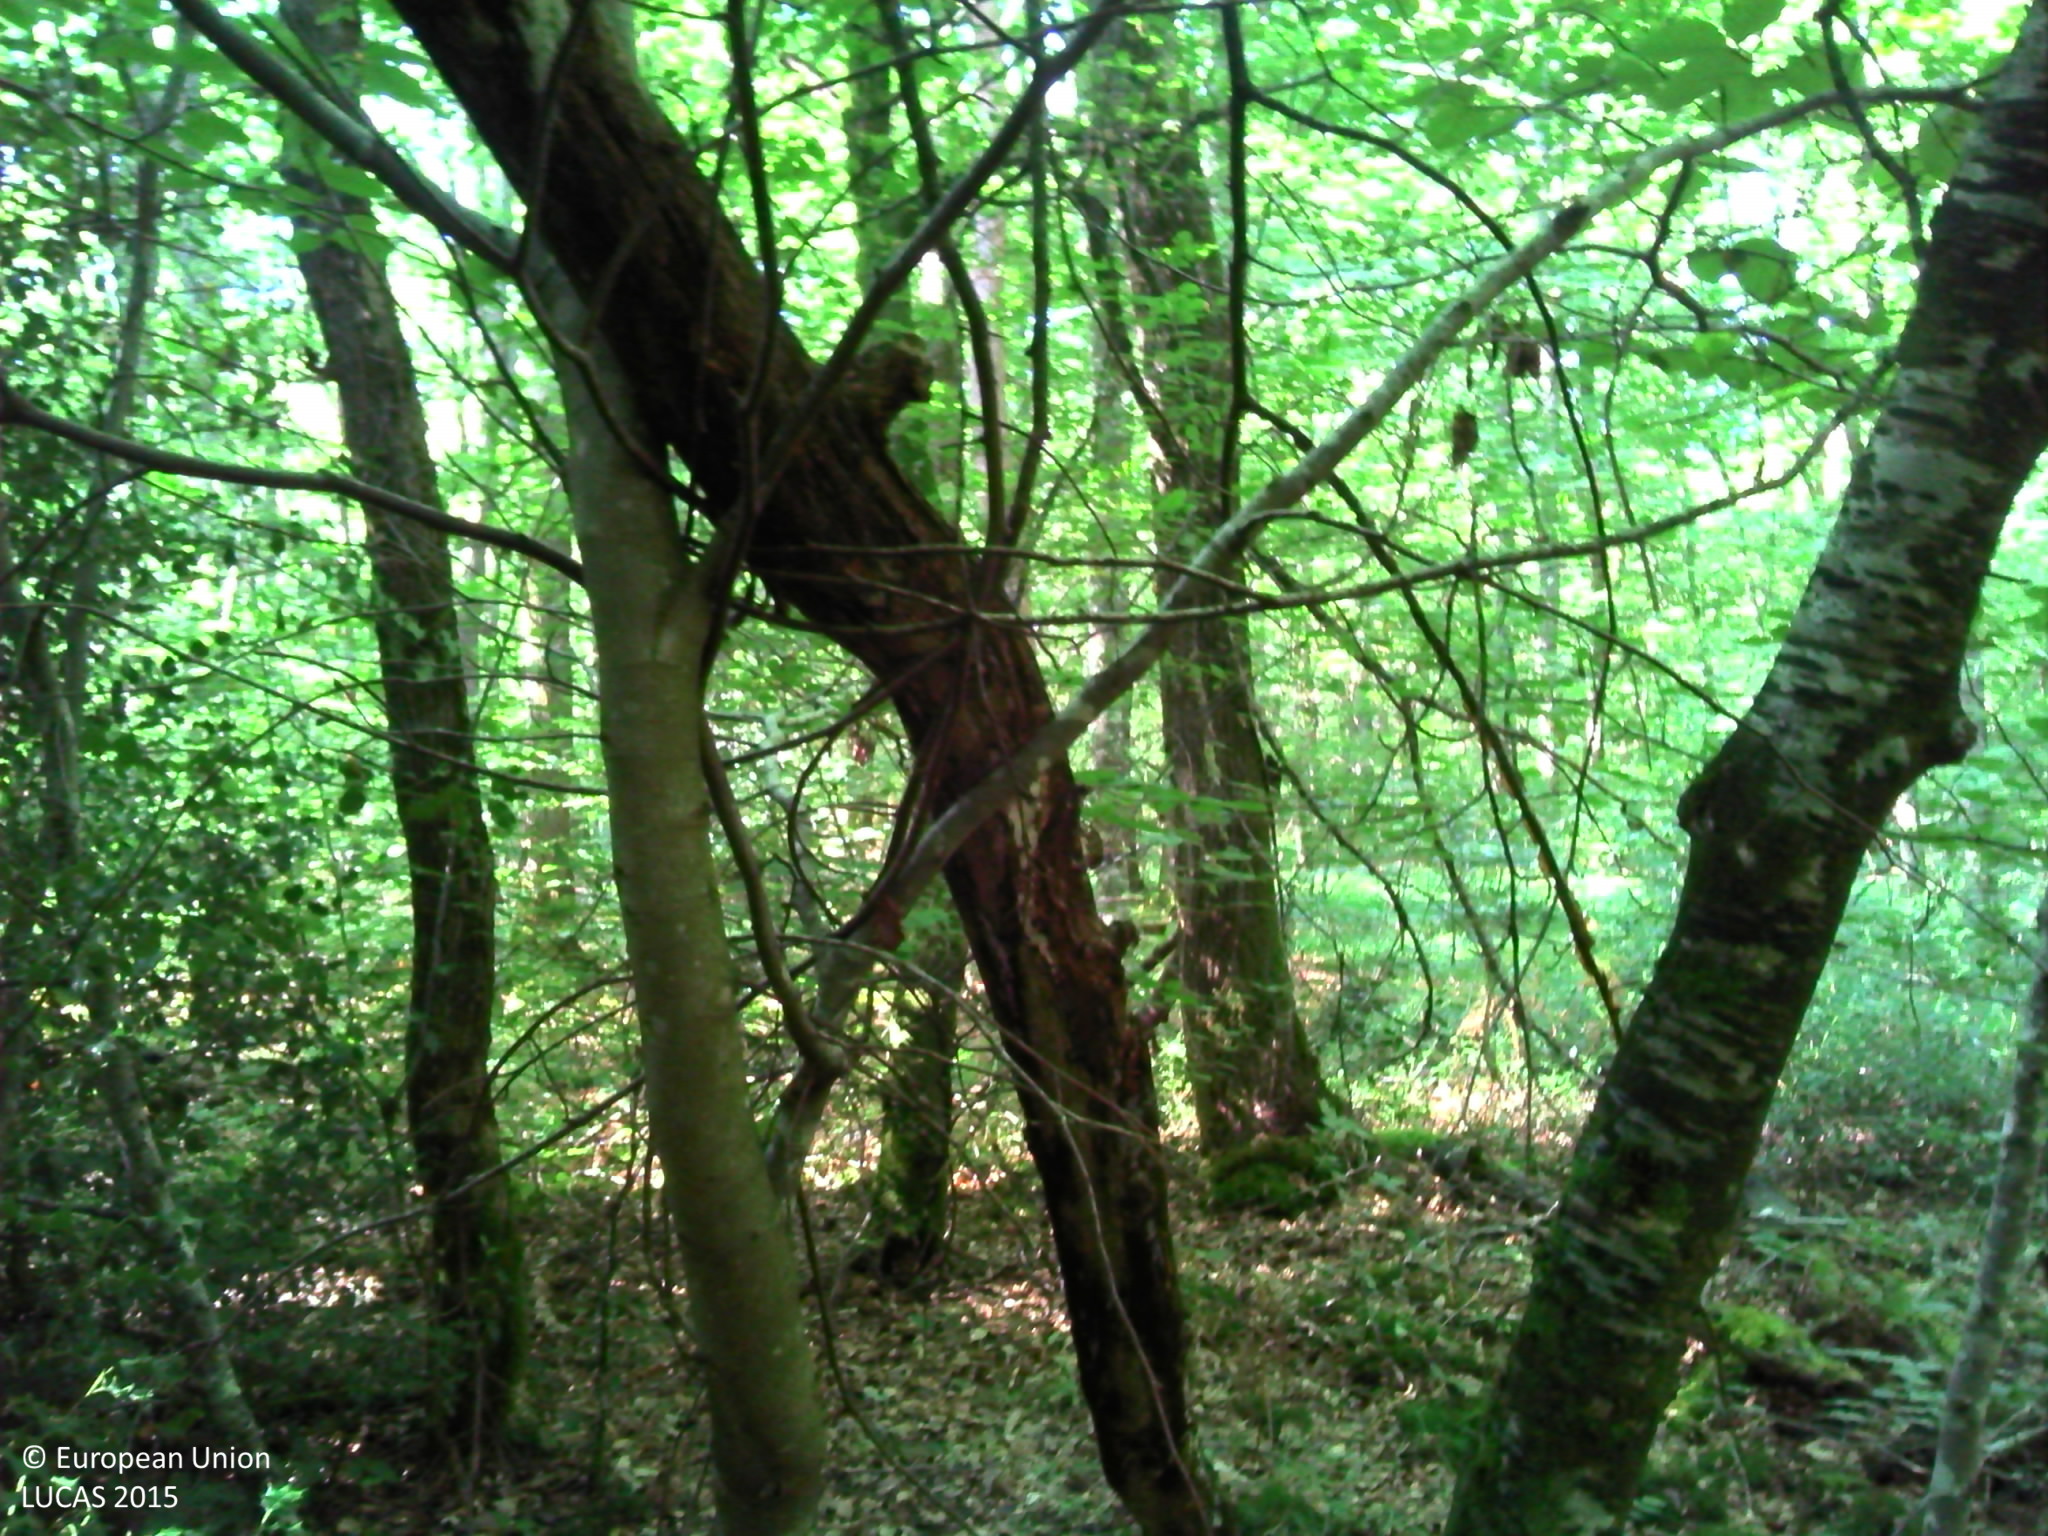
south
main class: Woodland
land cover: Broadleaved woodland
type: beech forest
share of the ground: > 75 %
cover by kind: broadleaved forest trees 90 %, herbaceous plants 5 %, lichens and mosses 5 %
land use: Forestry
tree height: > 5 m
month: August
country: FR
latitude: 46.6470
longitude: 2.7443
